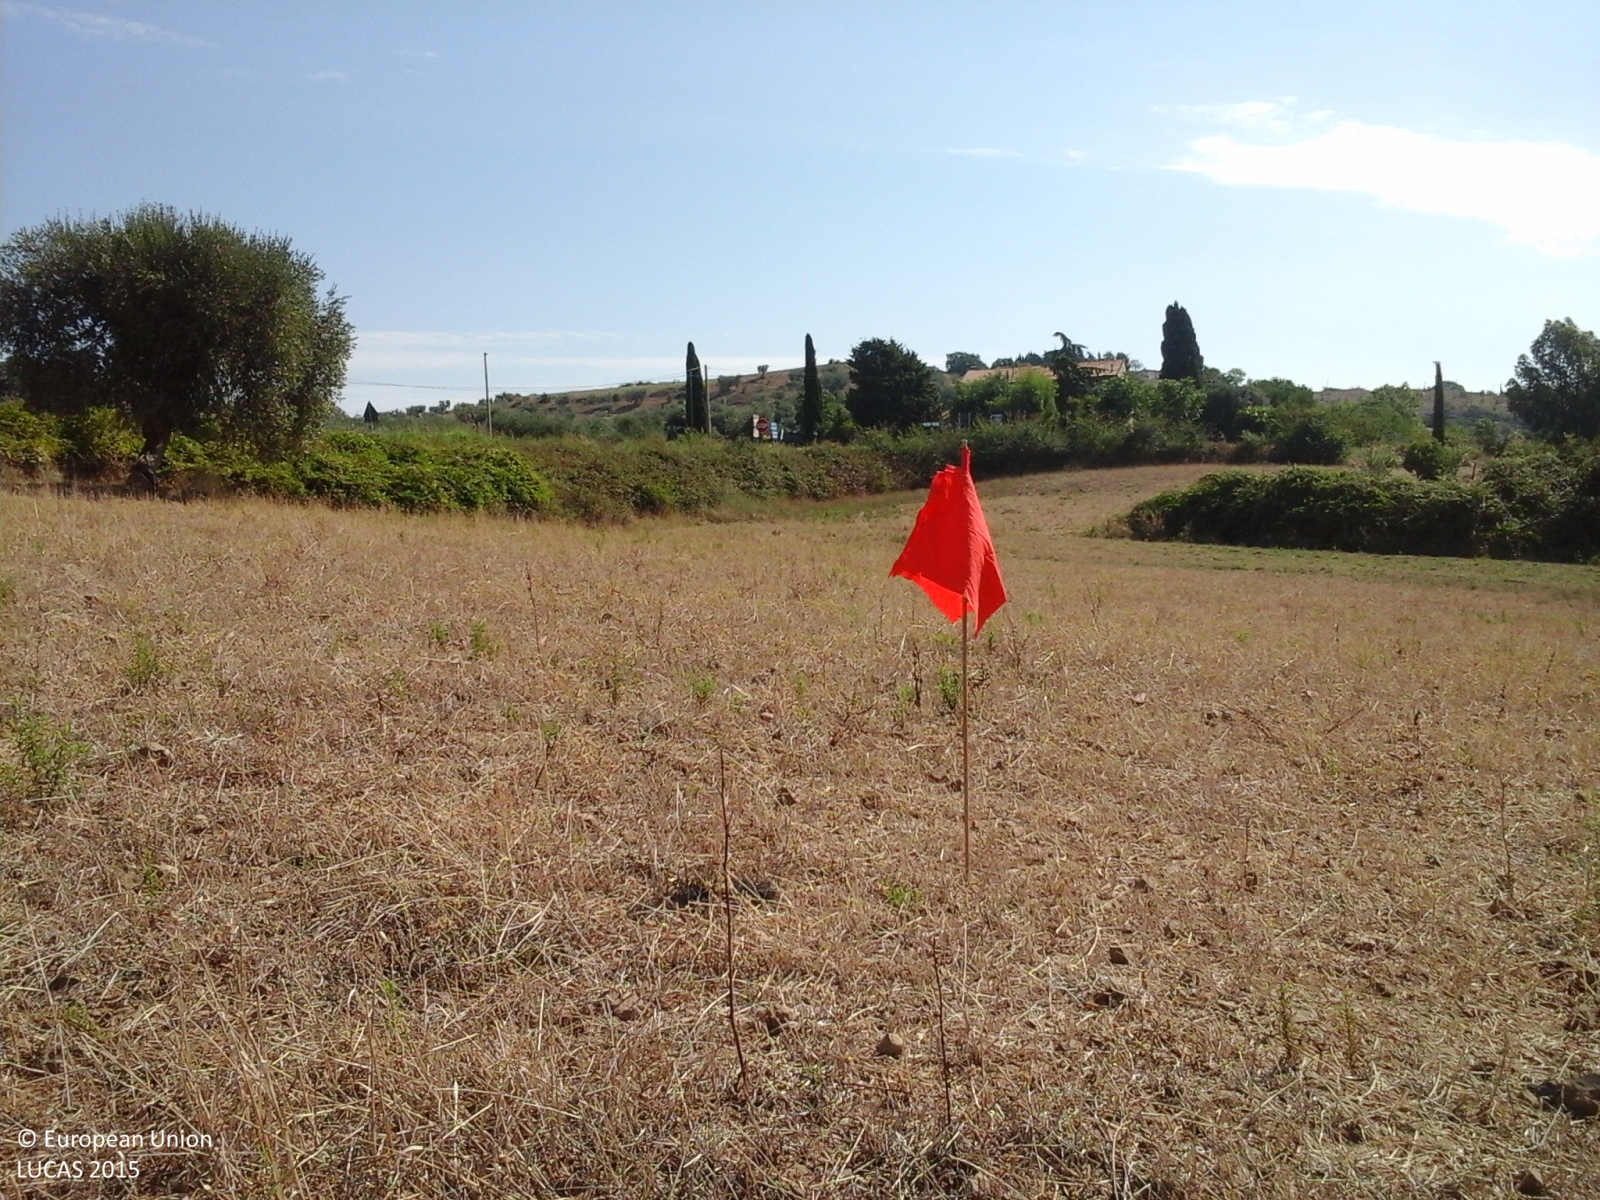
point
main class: Cropland
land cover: Temporary grasslands
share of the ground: > 75 %
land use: Agriculture (excluding fallow land and kitchen gardens)
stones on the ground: < 10 %
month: August
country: IT
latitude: 42.6285
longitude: 11.2274
